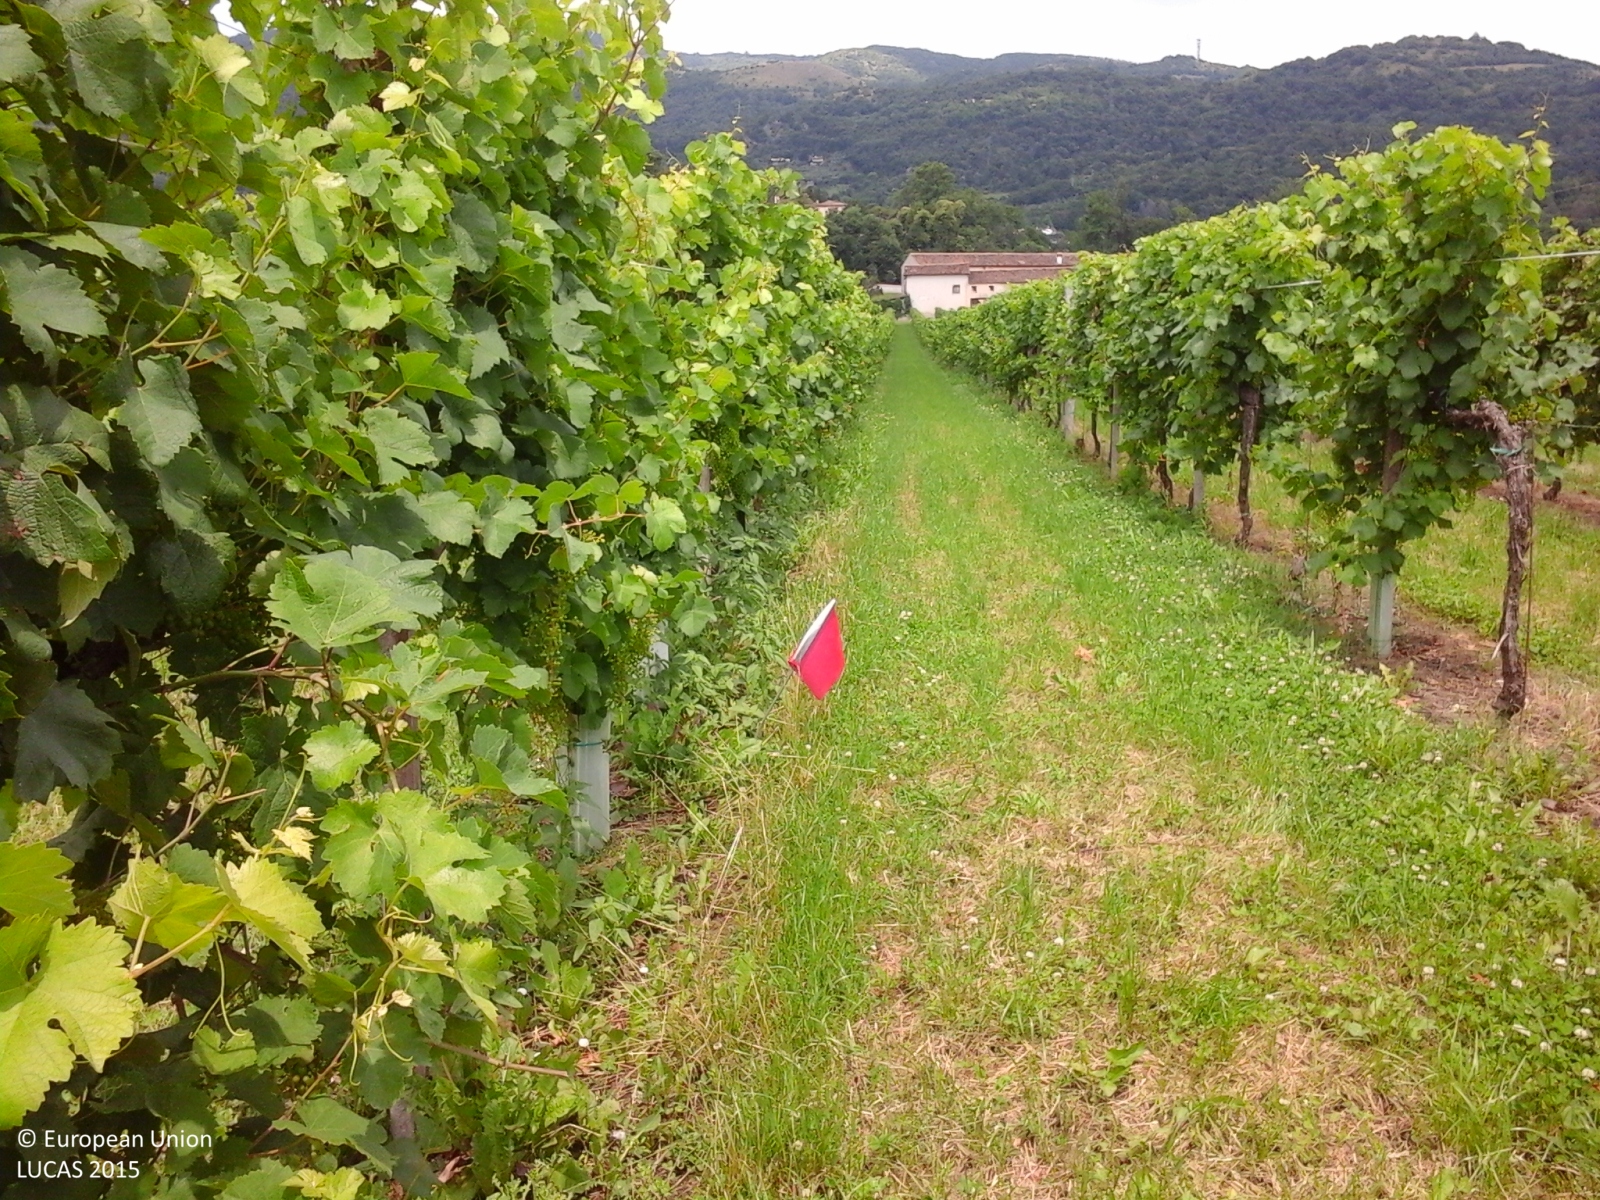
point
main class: Cropland
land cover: Vineyards
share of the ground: 25 - 50 %
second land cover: Grassland without tree/shrub cover
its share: > 75 %
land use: Agriculture (excluding fallow land and kitchen gardens)
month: June
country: IT
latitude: 45.9636
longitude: 12.4099
